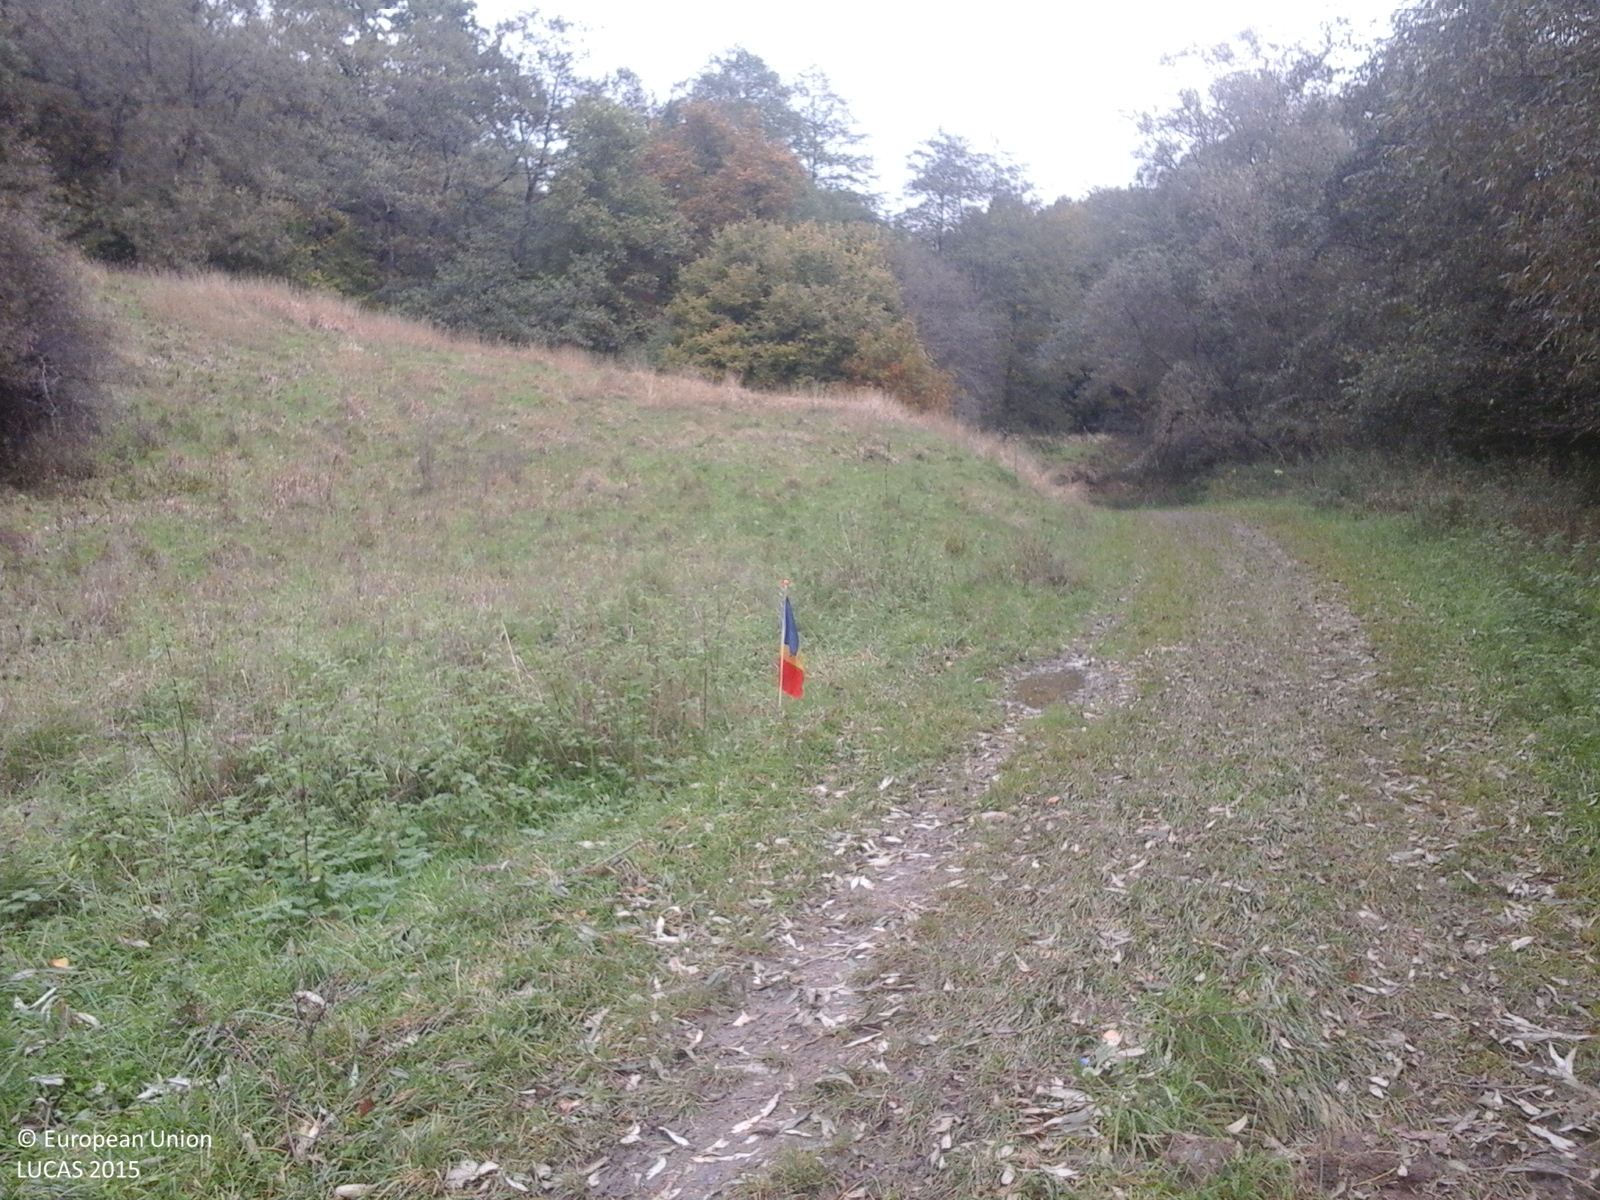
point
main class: Grassland
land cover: Grassland without tree/shrub cover
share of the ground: > 75 %
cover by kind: herbaceous plants 100 %
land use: Agriculture (excluding fallow land and kitchen gardens)
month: October
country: RO
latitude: 45.8515
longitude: 24.7555
